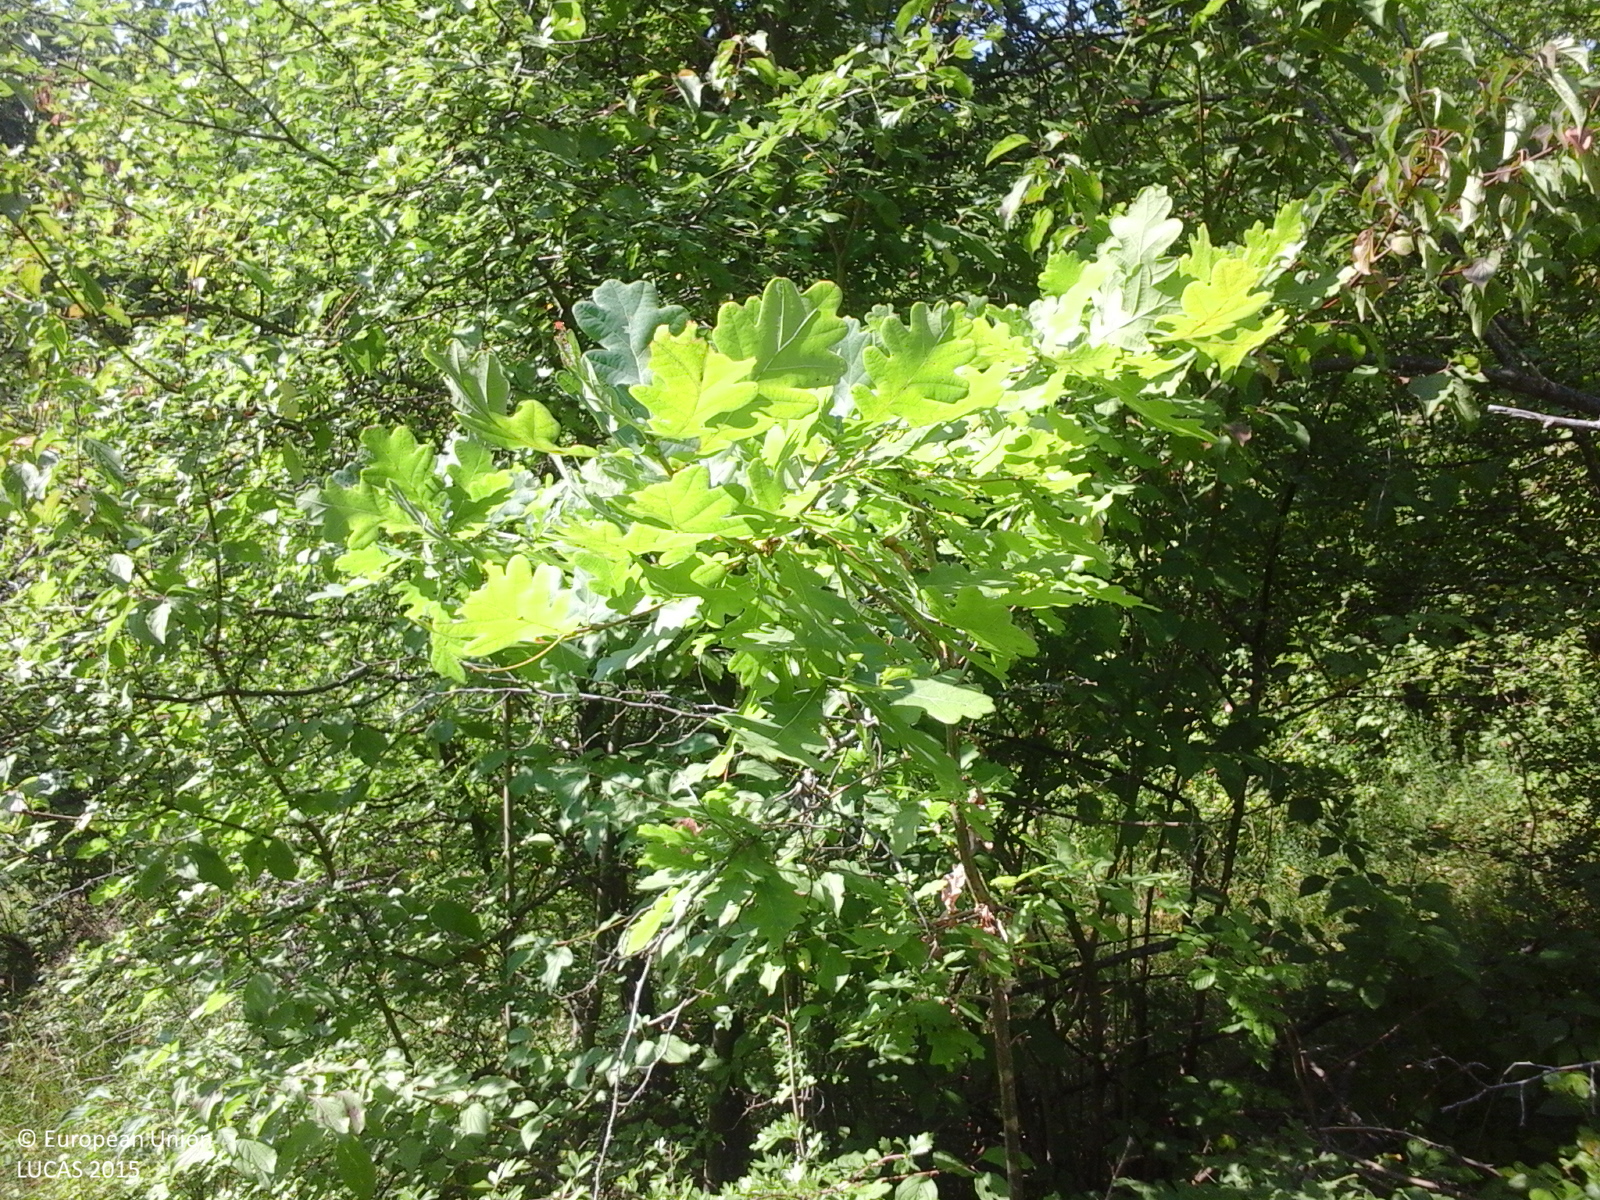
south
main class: Woodland
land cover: Broadleaved woodland
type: acidophilous oak and oak-birch forest
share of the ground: > 75 %
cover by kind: broadleaved forest trees 100 %
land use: Forestry
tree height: > 5 m
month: July
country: RO
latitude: 44.7975
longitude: 24.5748
